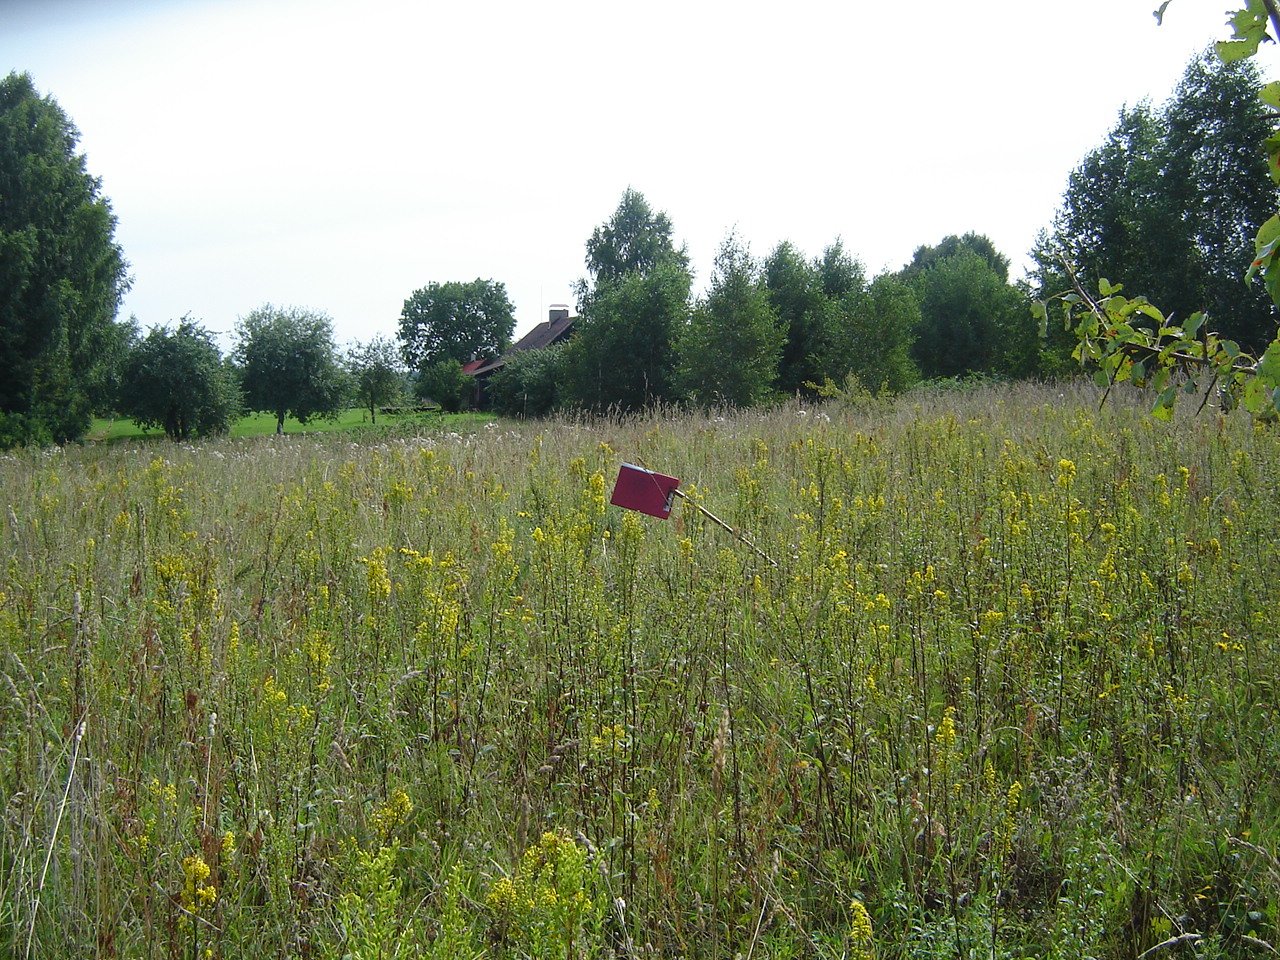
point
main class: Grassland
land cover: Grassland with sparse tree/shrub cover
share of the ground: > 75 %
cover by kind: herbaceous plants 90 %, broadleaved forest trees 5 %, shrubs 5 %
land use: Agriculture (excluding fallow land and kitchen gardens)
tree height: > 5 m
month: August
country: LT
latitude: 54.9274
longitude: 24.8887
